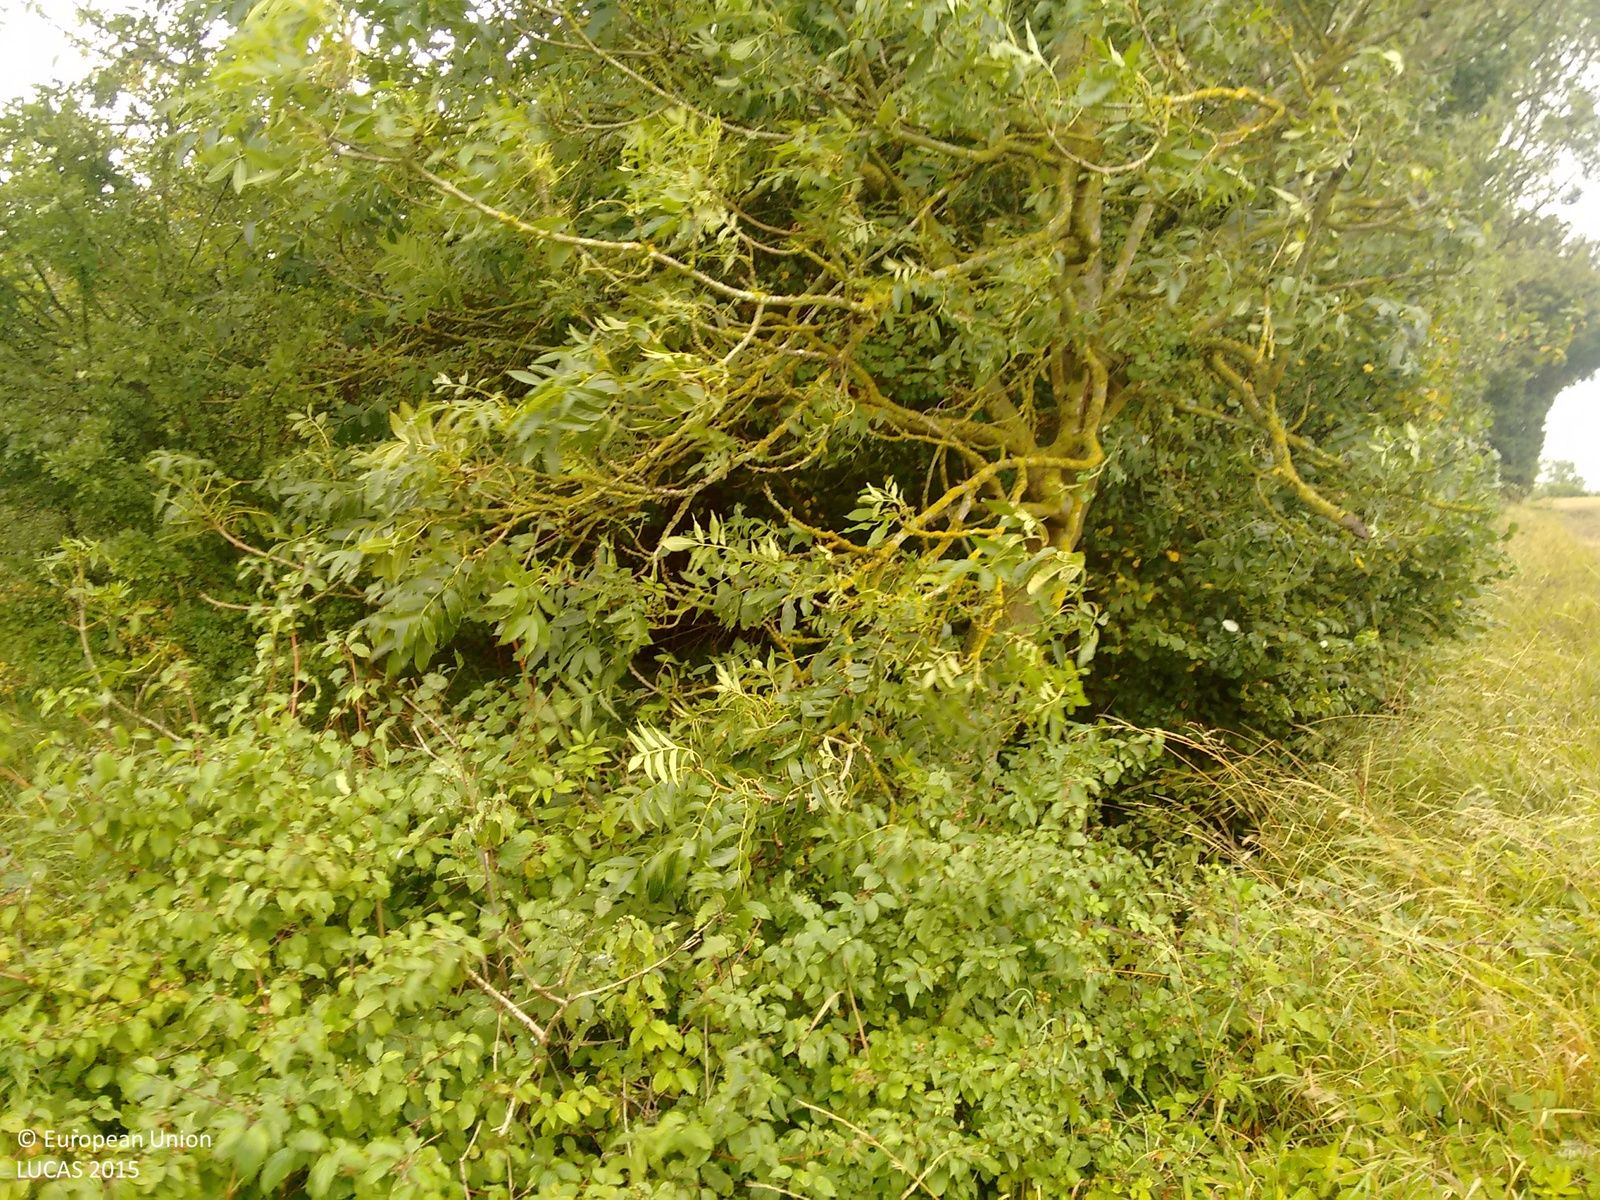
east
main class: Woodland
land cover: Other mixed woodland
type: mesophytic deciduous forest
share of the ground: > 75 %
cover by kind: broadleaved forest trees 70 %, coniferous forest trees 25 %, shrubs 5 %
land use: Semi-natural and natural areas not in use
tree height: > 5 m
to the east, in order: Other mixed woodland; Ditches and canals; Abandoned hedges; Grass margins; Tracks; Grass margins; Managed hedges; Other bare soil
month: August
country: GB
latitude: 52.1242
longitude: 0.5222
